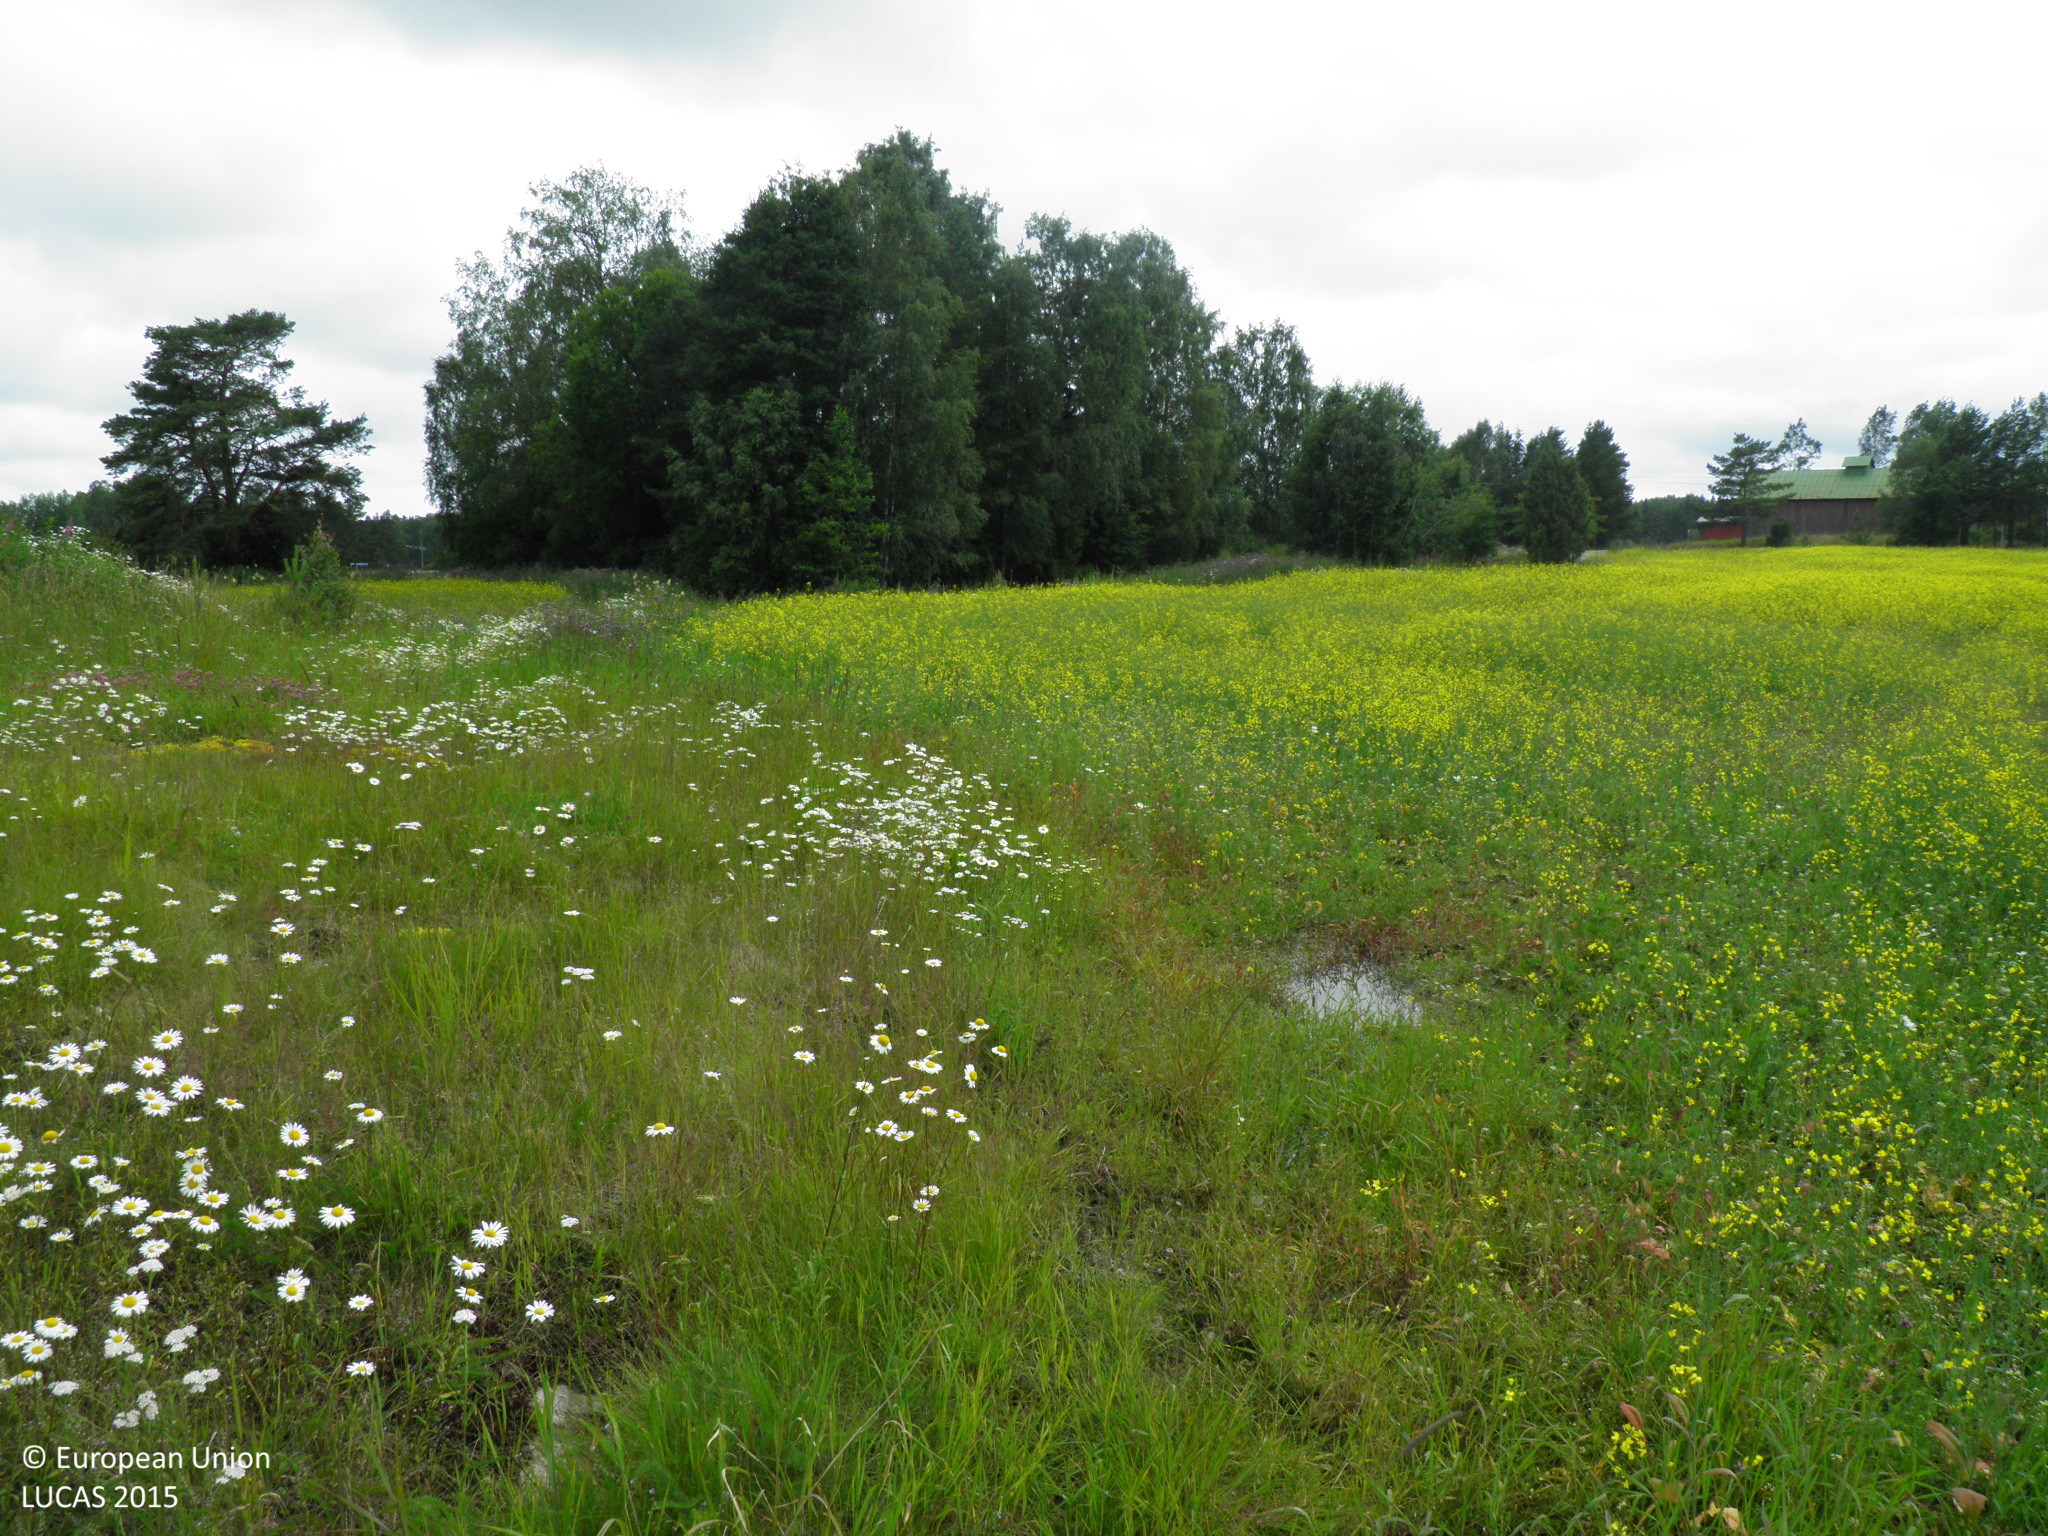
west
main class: Cropland
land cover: Rape and turnip rape
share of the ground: > 75 %
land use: Agriculture (excluding fallow land and kitchen gardens)
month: July
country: FI
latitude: 60.6158
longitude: 21.5489
